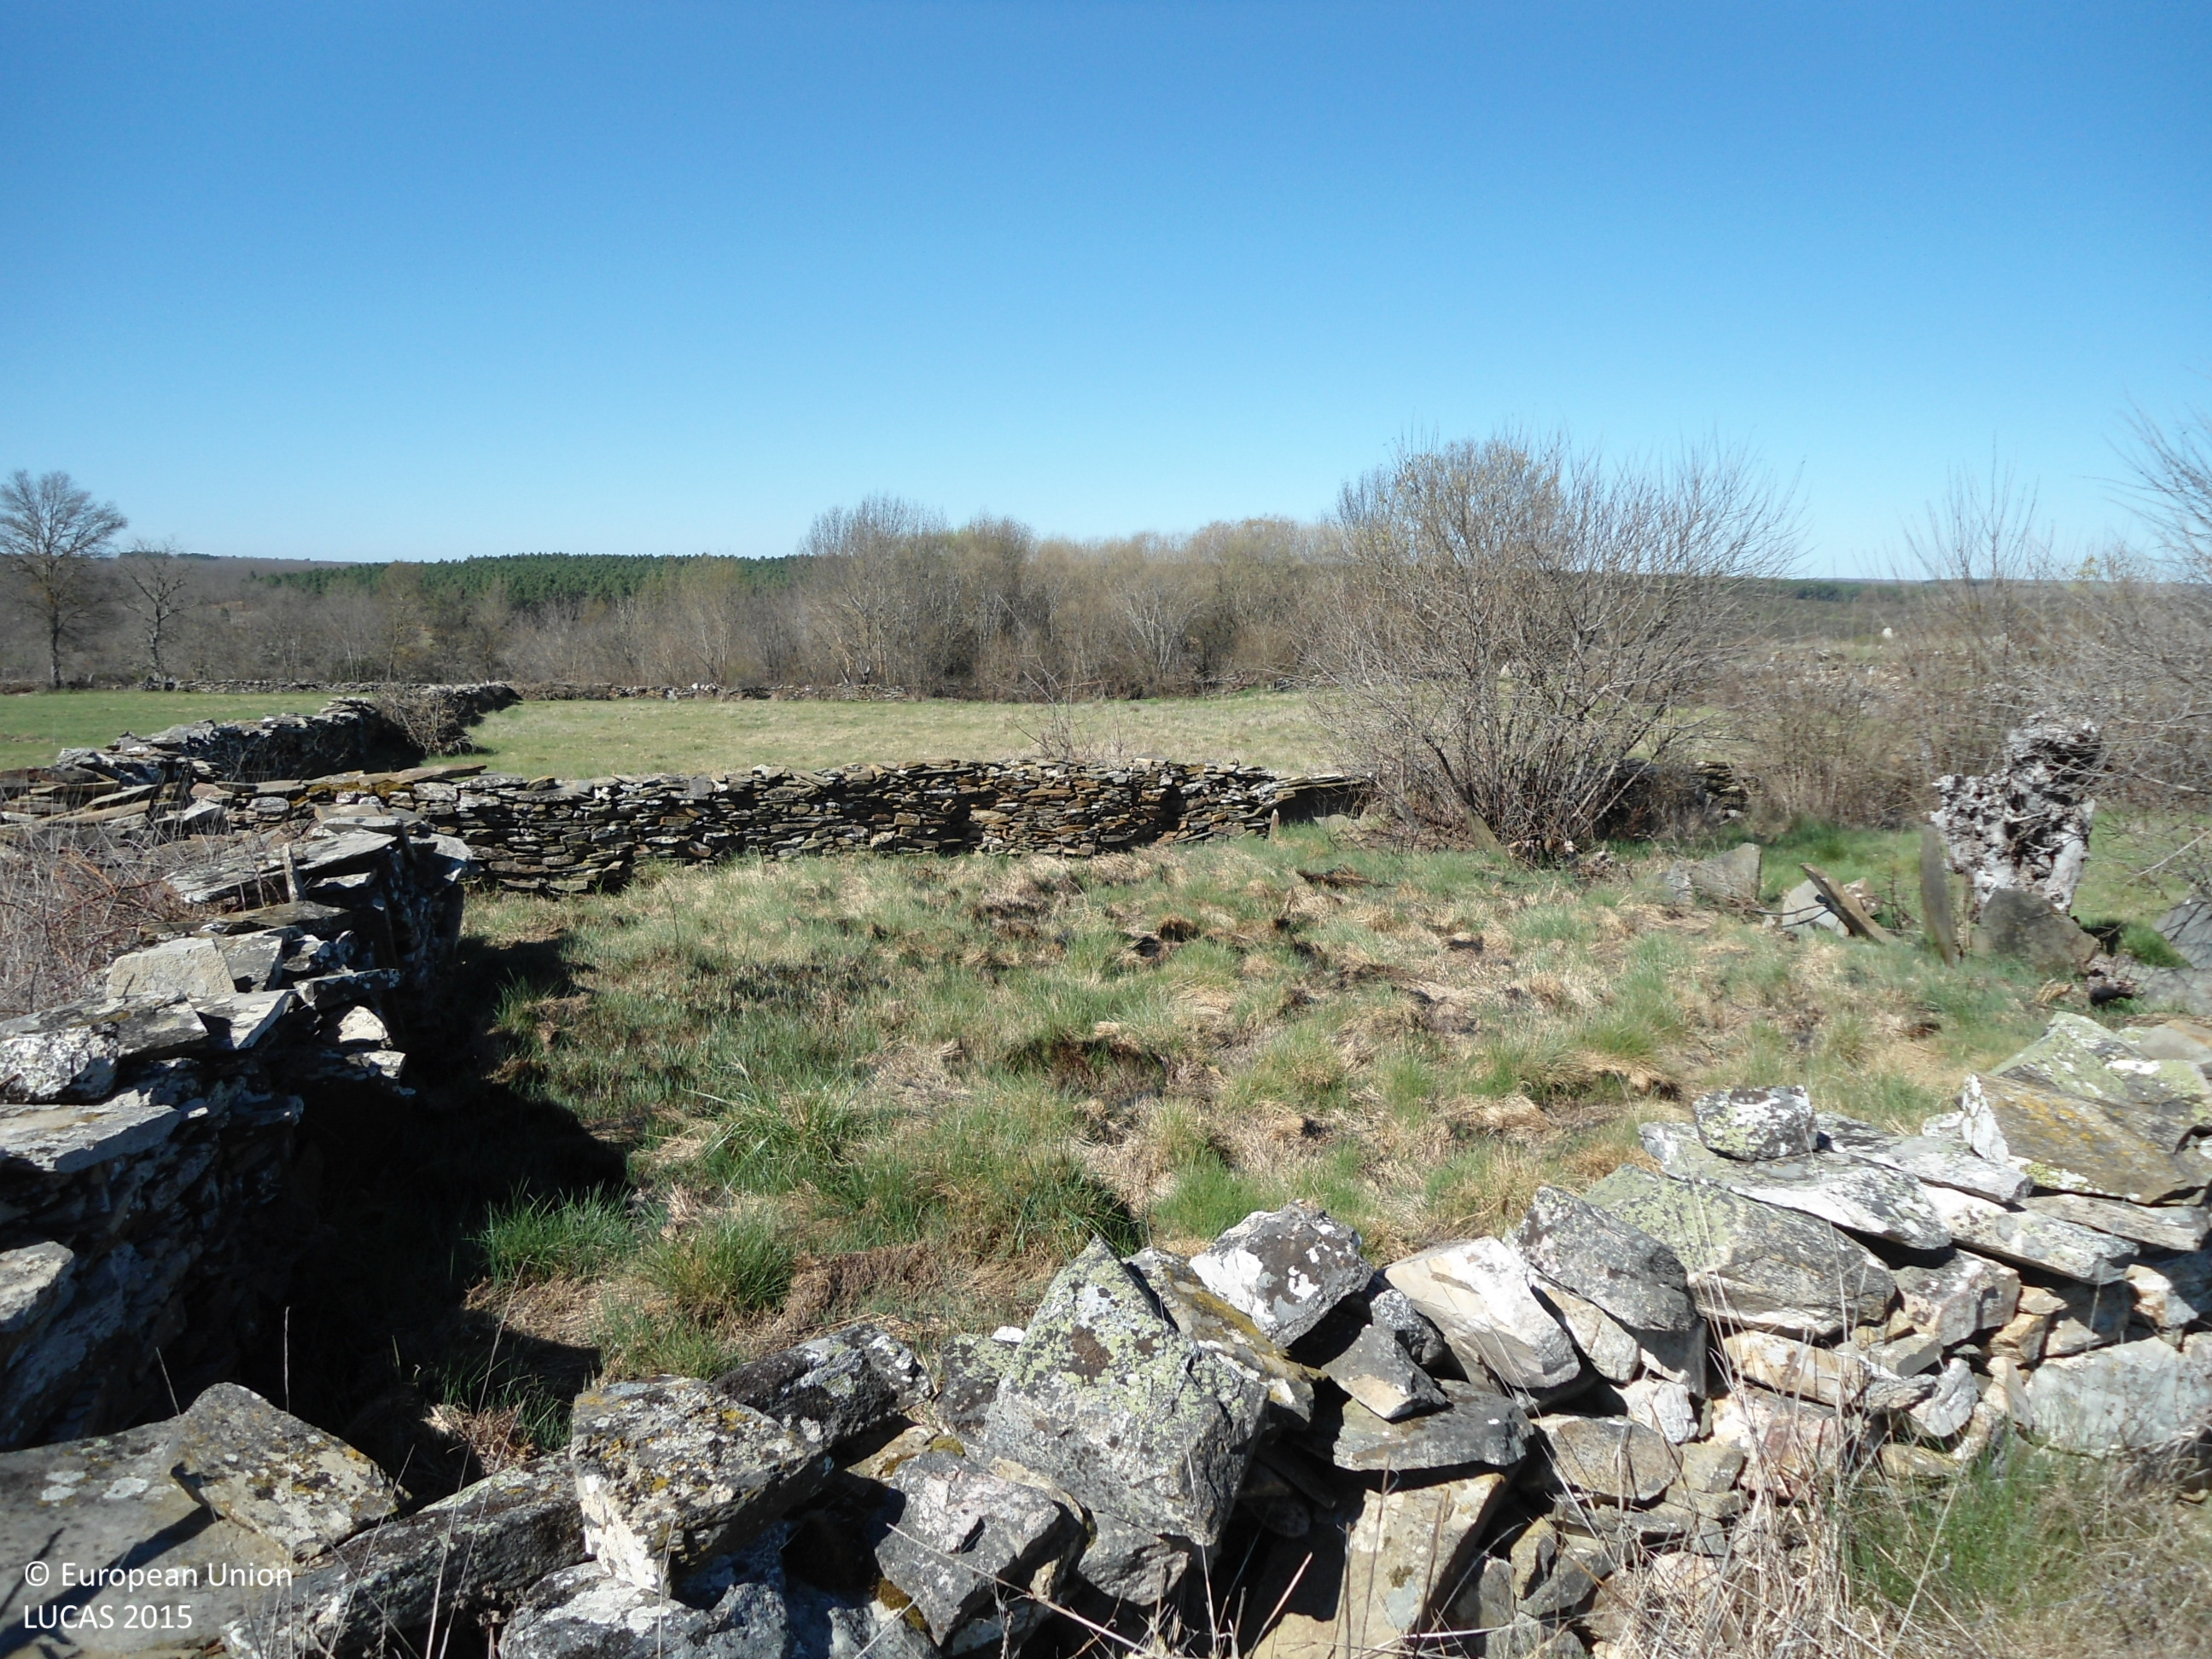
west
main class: Grassland
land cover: Grassland without tree/shrub cover
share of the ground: > 75 %
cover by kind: herbaceous plants 100 %
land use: Agriculture (excluding fallow land and kitchen gardens)
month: April
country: ES
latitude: 41.7012
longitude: -6.2382
